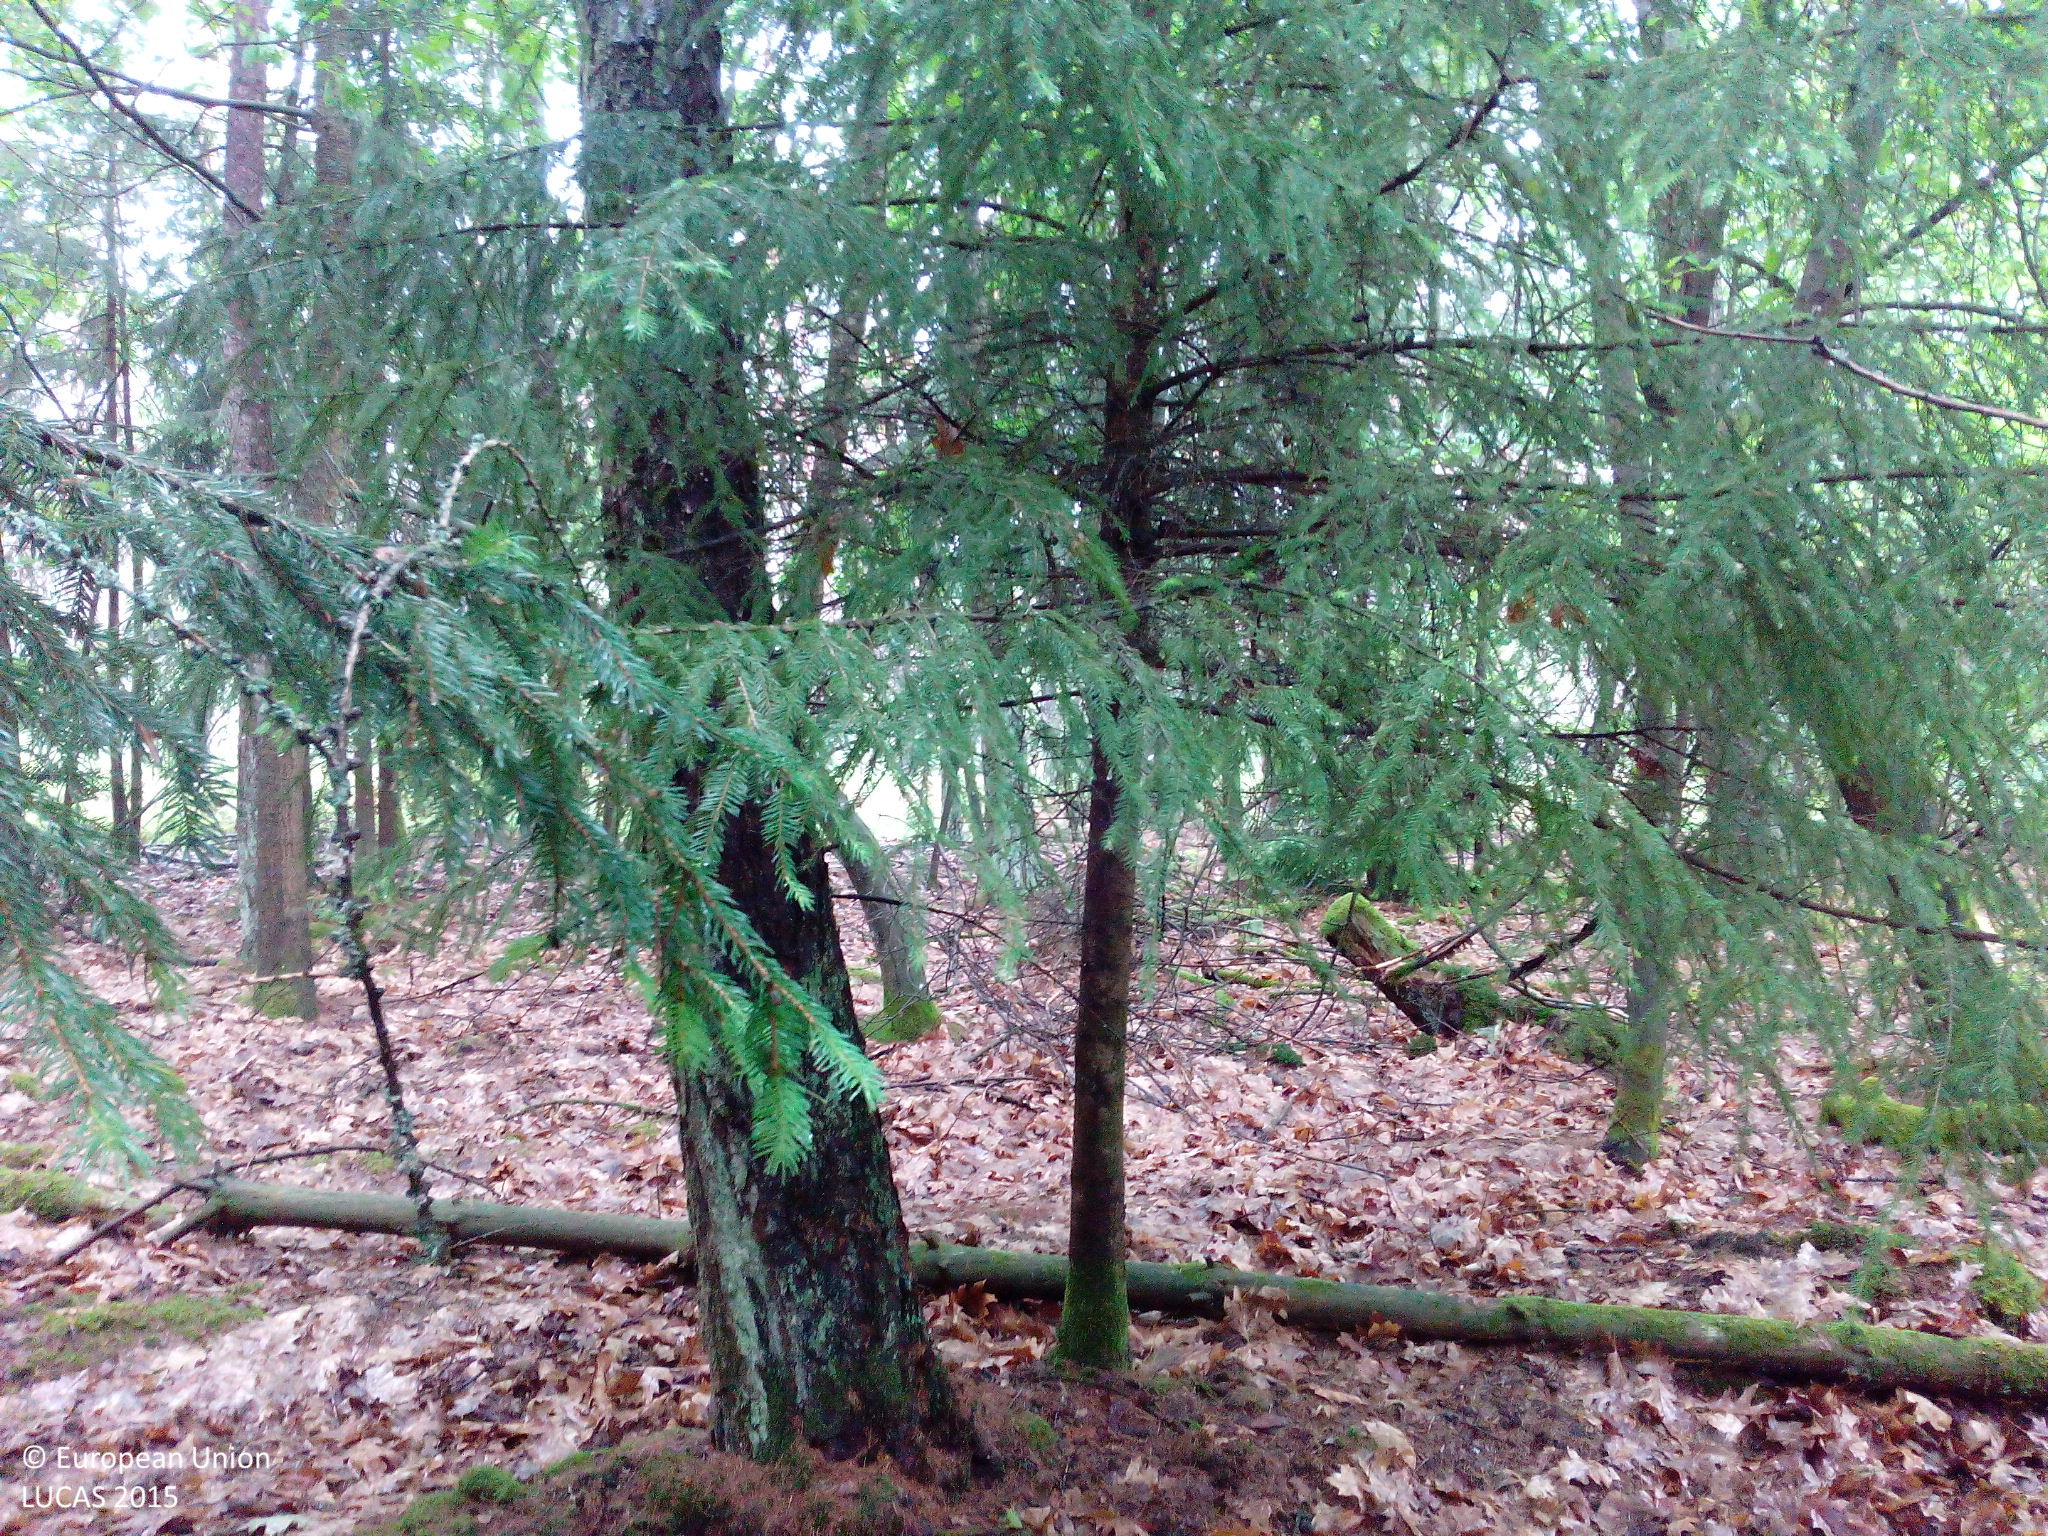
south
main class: Woodland
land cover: Other mixed woodland
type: hemiboreal forest and nemoral coniferous forest and mixed broadleaved-coniferous forest
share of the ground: > 75 %
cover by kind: coniferous forest trees 75 %, broadleaved forest trees 25 %
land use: Forestry
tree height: > 5 m
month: June
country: DE
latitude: 49.2632
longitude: 12.2119
